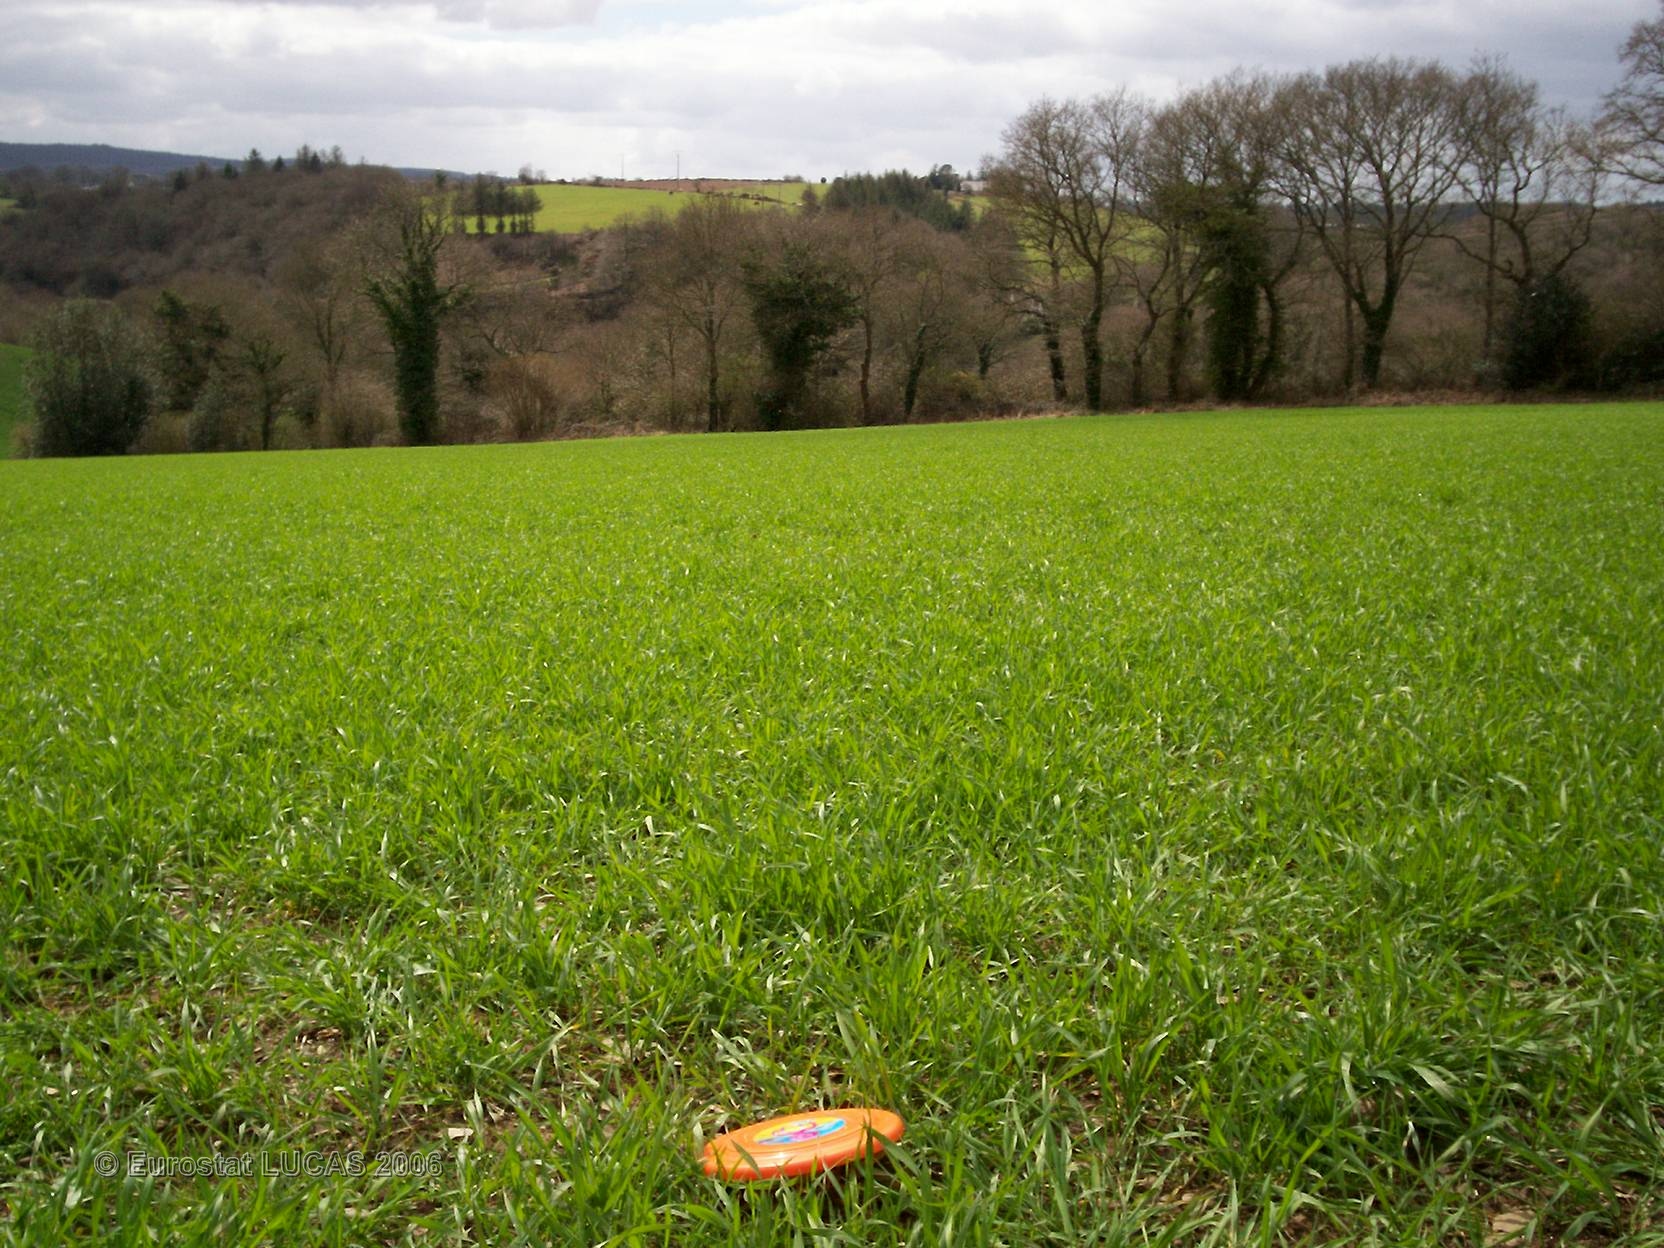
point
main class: Cropland
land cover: Common wheat
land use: Agriculture (excluding fallow land and kitchen gardens)
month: April
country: FR
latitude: 48.2178
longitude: -3.5788
